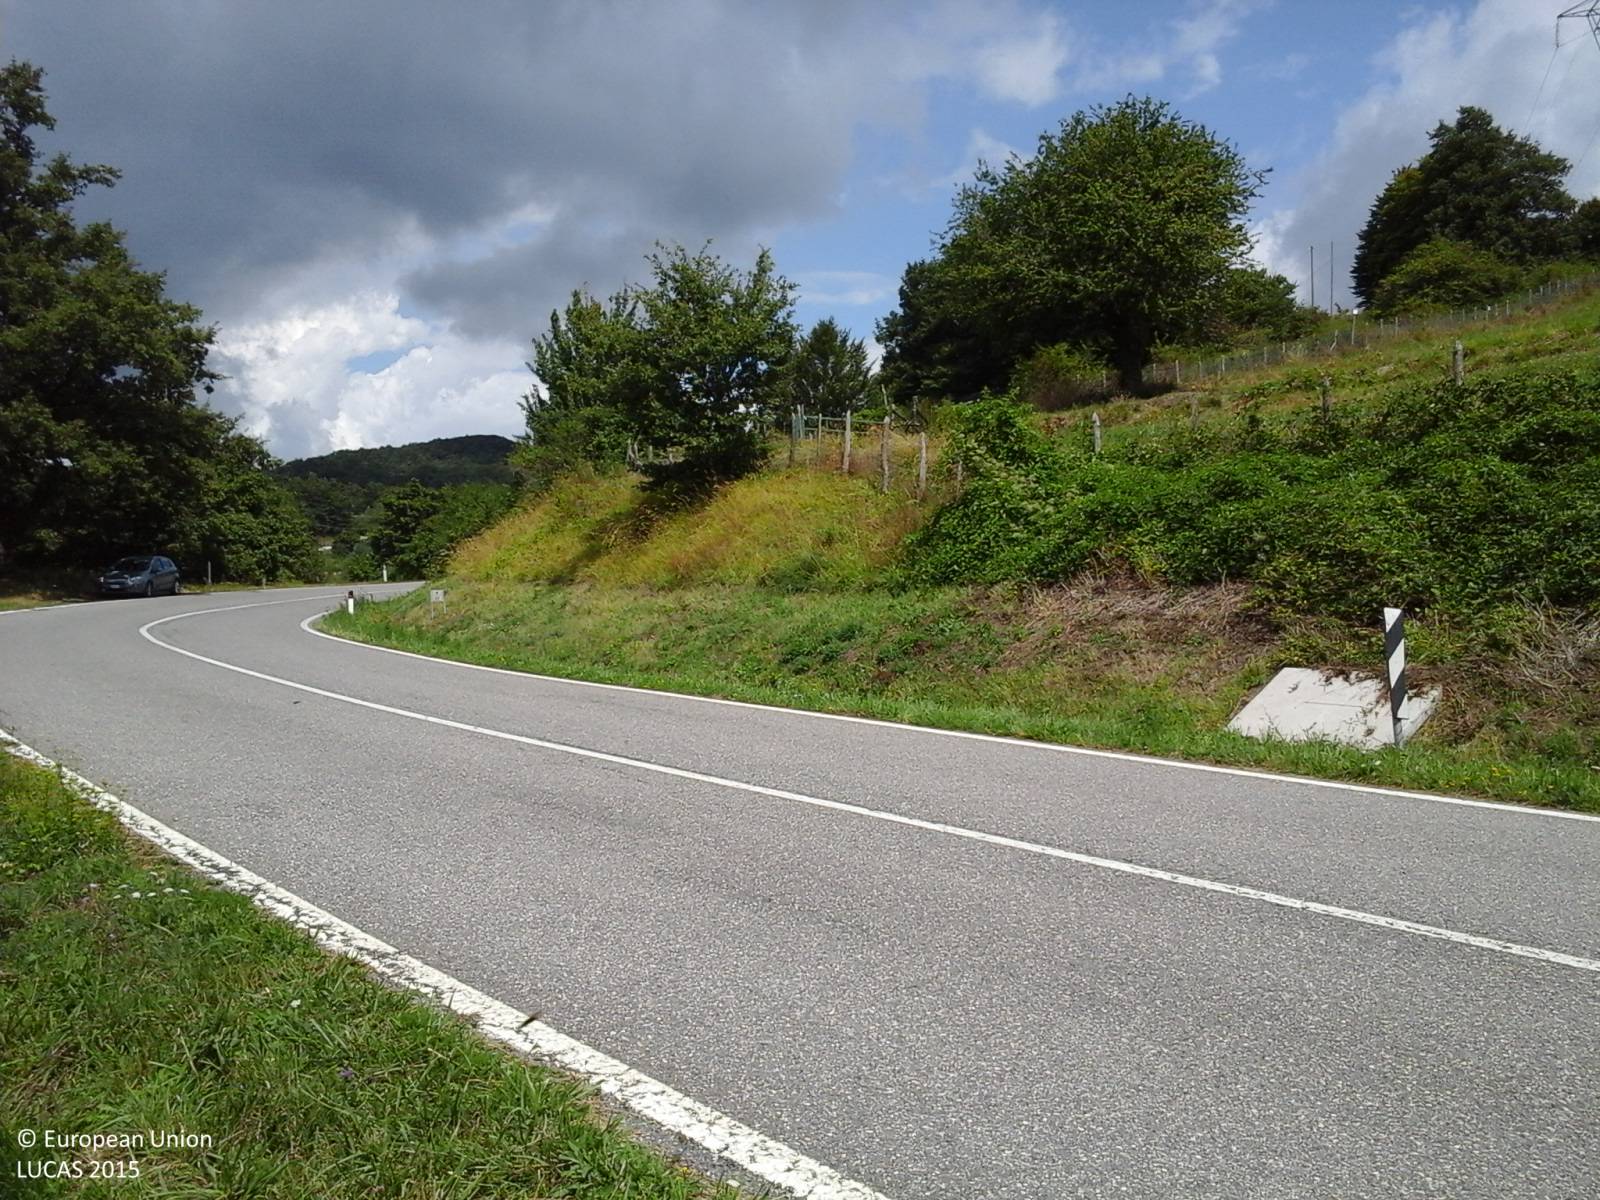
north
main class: Woodland
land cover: Broadleaved woodland
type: thermophilous deciduous forest
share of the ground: > 75 %
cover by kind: broadleaved forest trees 80 %, shrubs 20 %
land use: Forestry
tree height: > 5 m
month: August
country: IT
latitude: 43.6793
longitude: 12.1157
